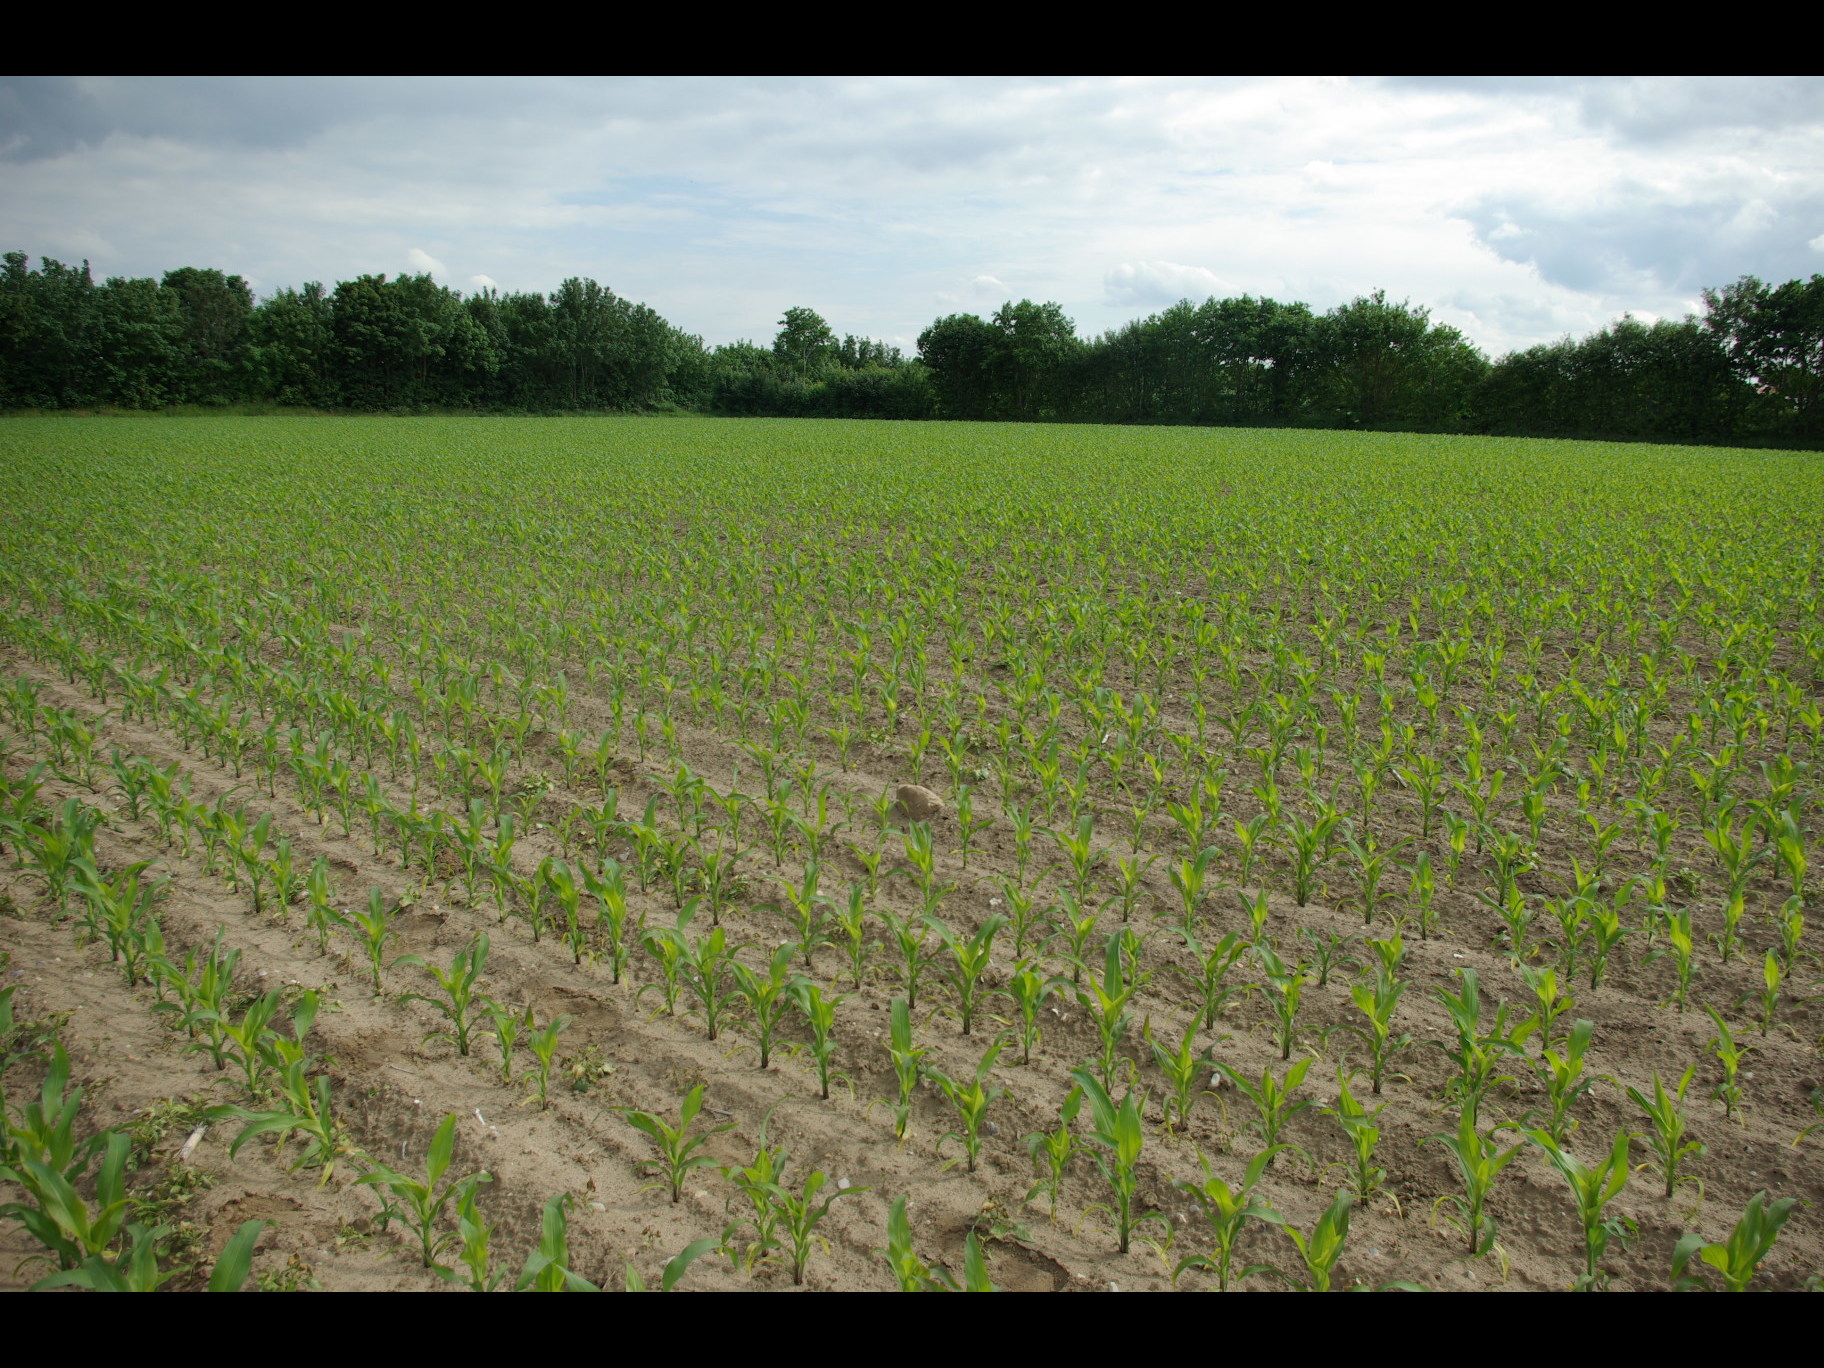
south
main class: Cropland
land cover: Maize
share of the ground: 25 - 50 %
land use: Agriculture (excluding fallow land and kitchen gardens)
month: June
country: DE
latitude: 54.1387
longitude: 9.8317
